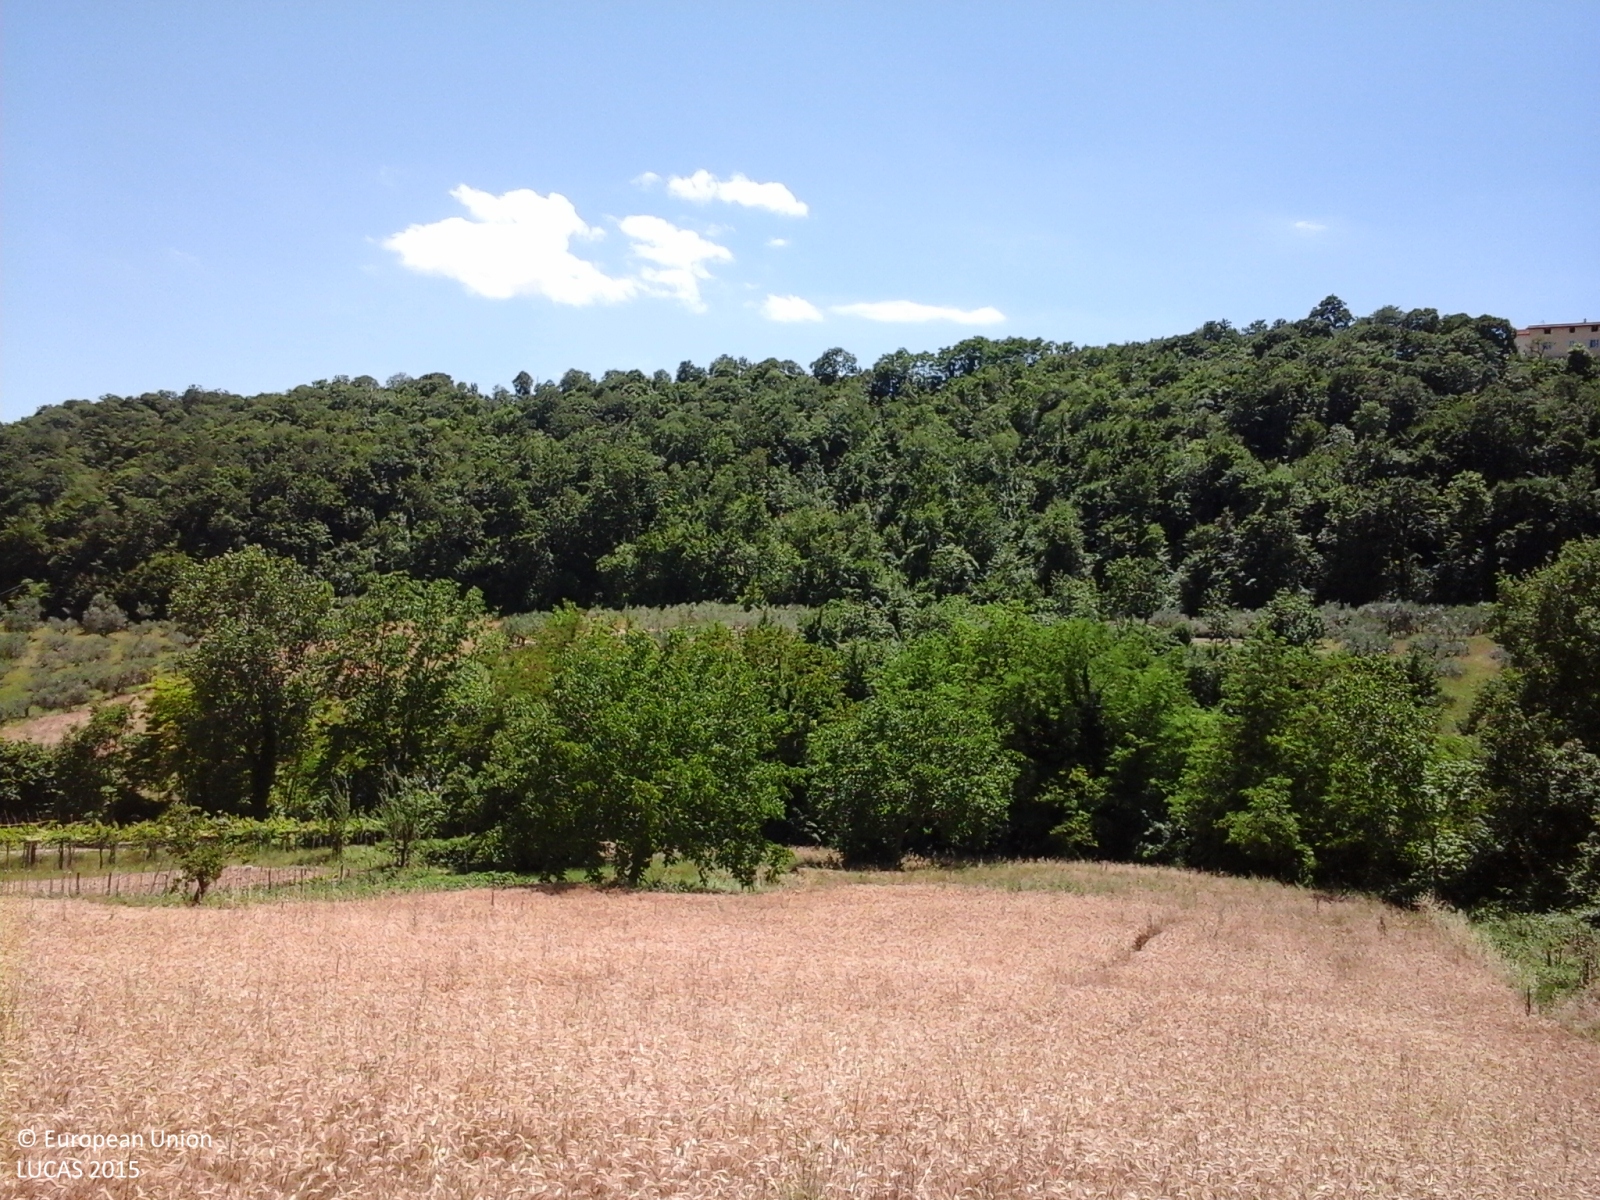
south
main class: Cropland
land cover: Triticale
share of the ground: > 75 %
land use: Agriculture (excluding fallow land and kitchen gardens)
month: June
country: IT
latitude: 42.1495
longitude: 14.2341
